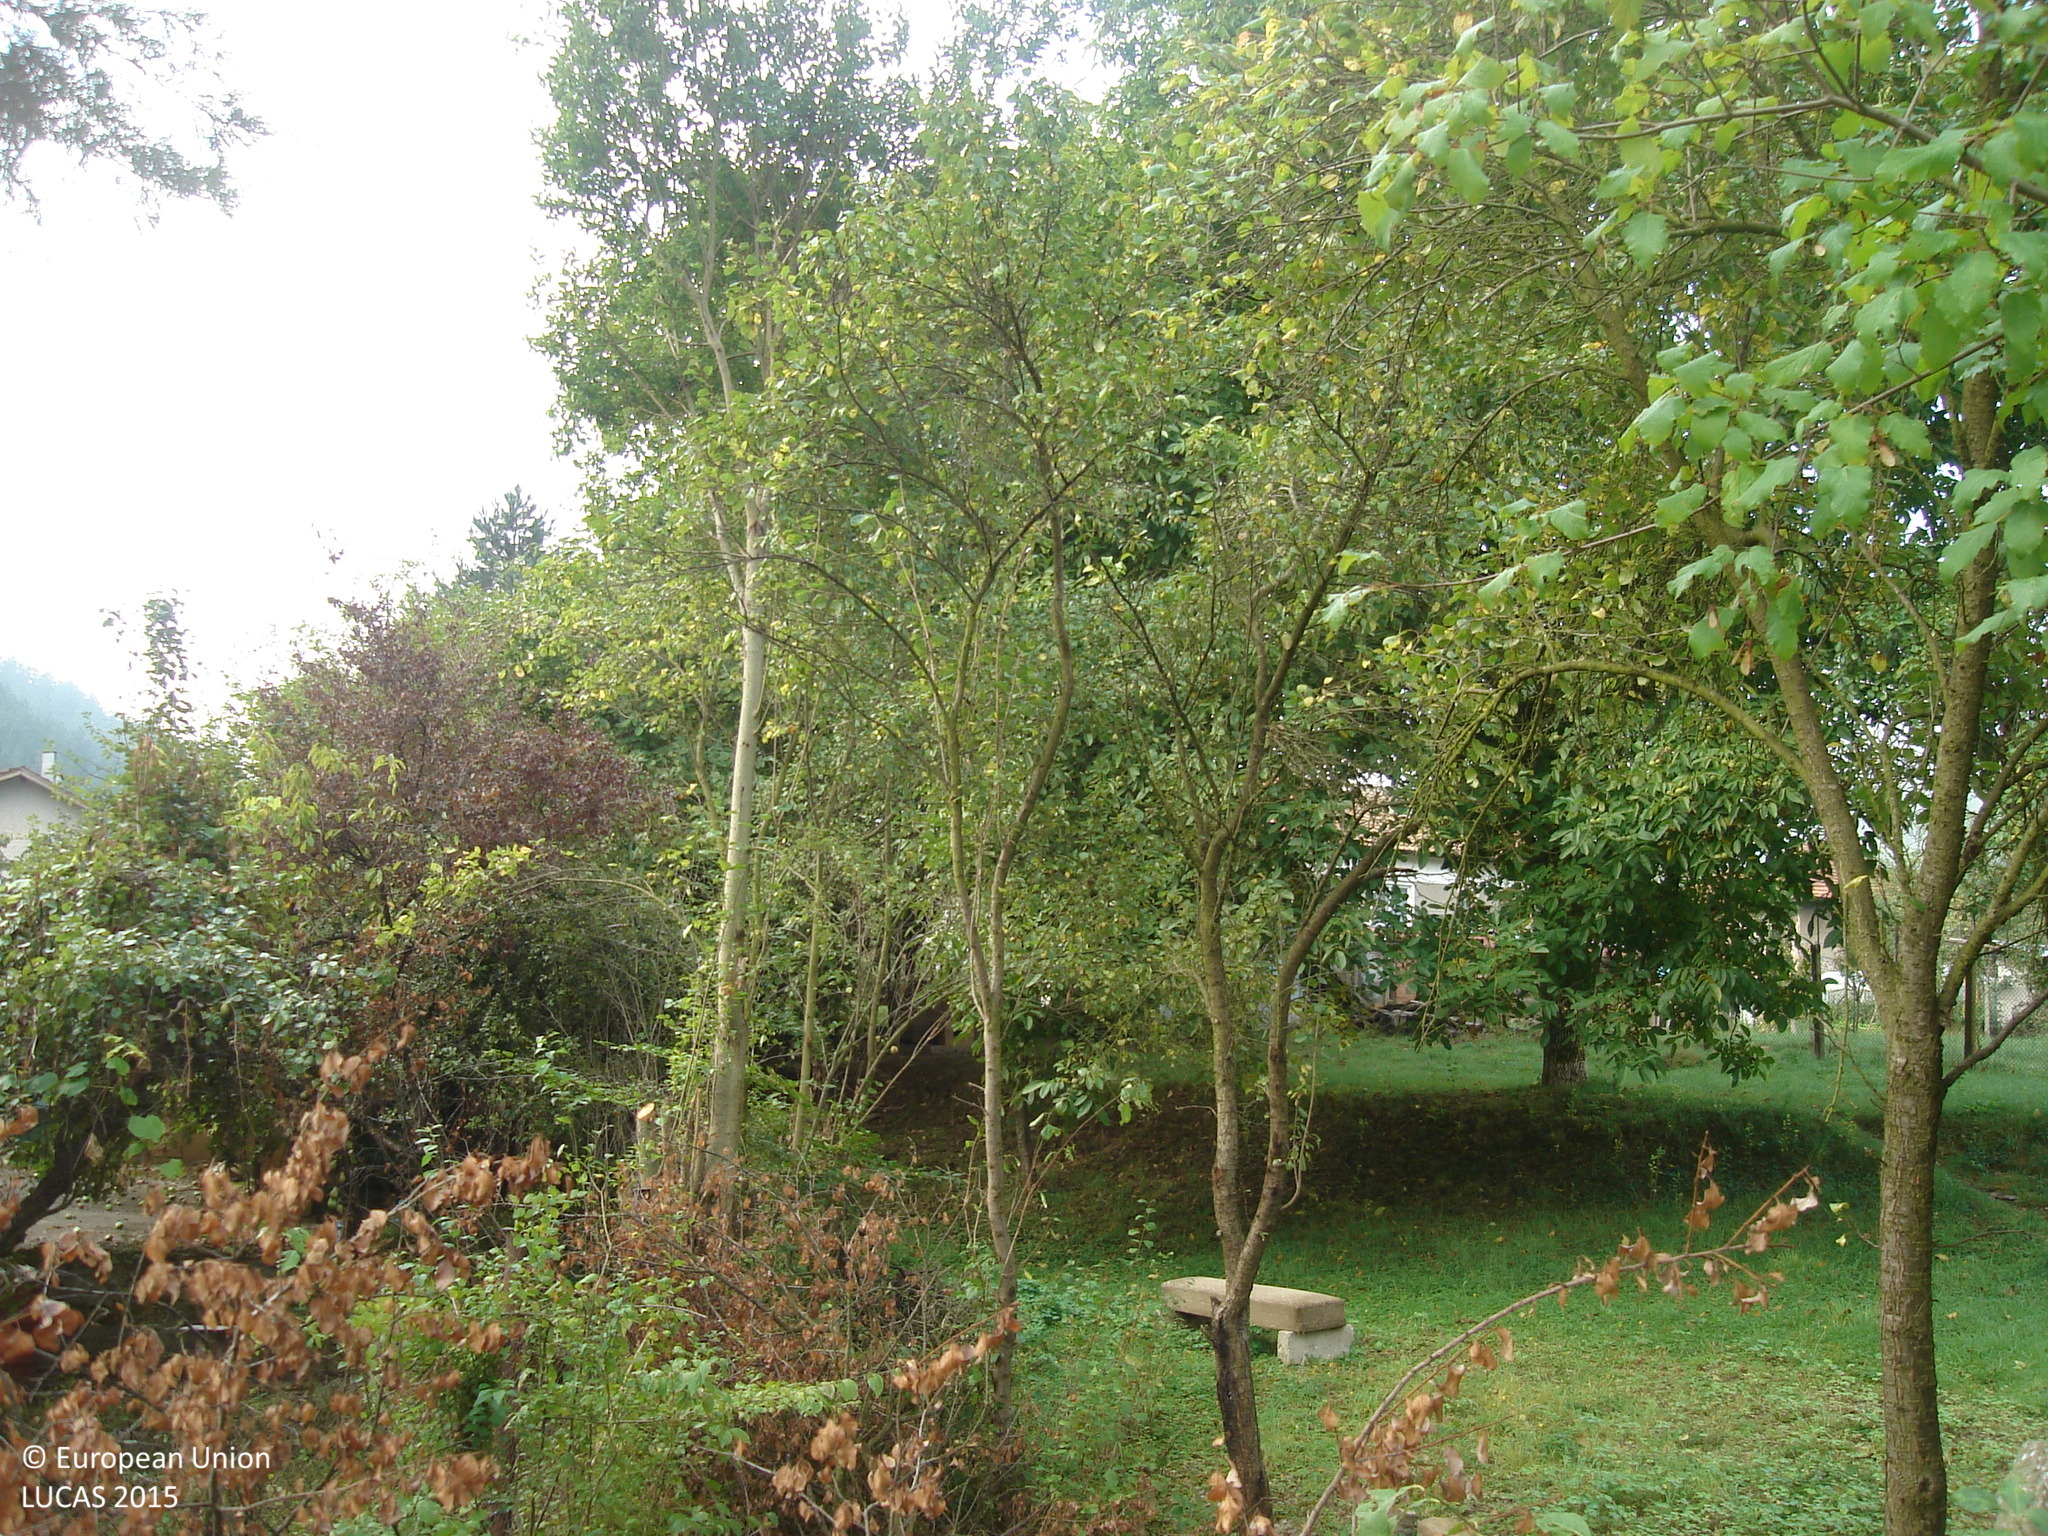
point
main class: Woodland
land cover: Broadleaved woodland
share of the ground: > 75 %
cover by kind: broadleaved forest trees 80 %
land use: Residential
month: September
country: BG
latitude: 42.9314
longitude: 23.3811
